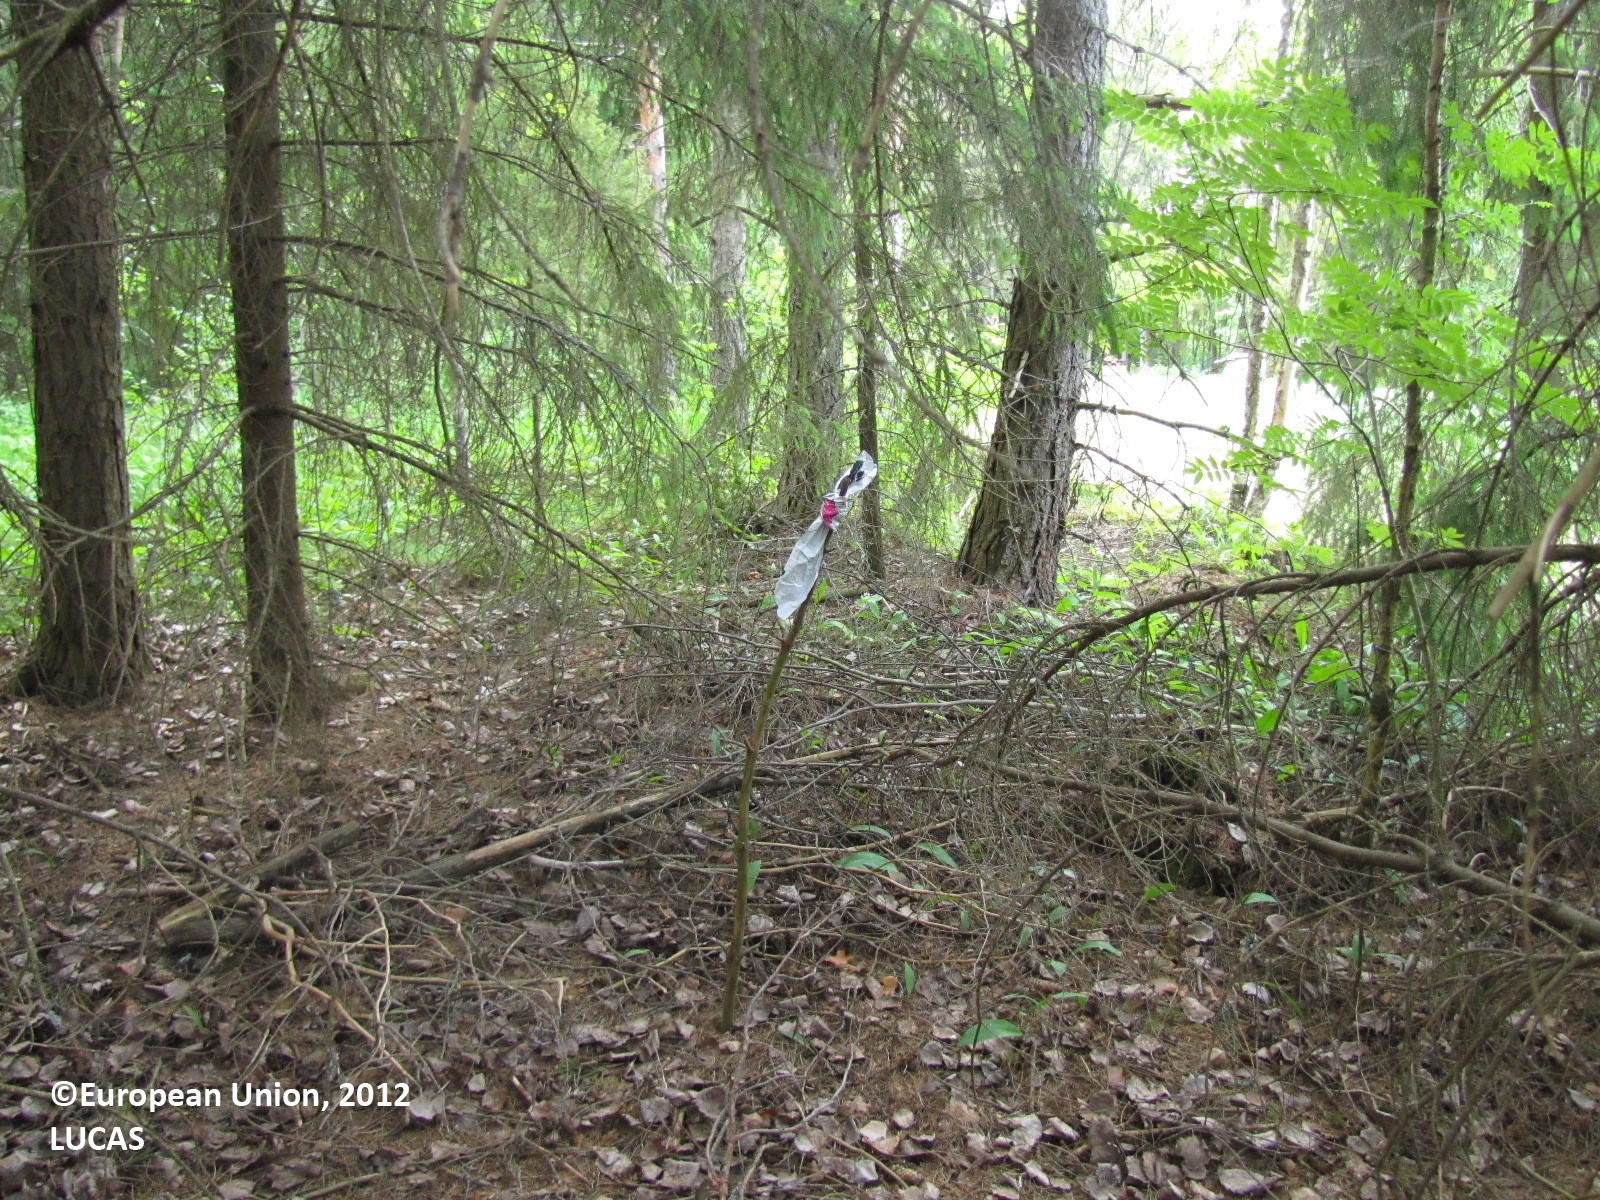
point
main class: Woodland
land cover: Spruce dominated coniferous woodland
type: boreal forest
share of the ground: 25 - 50 %
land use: Forestry
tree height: > 5 m
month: June
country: FI
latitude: 61.4897
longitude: 24.4266
